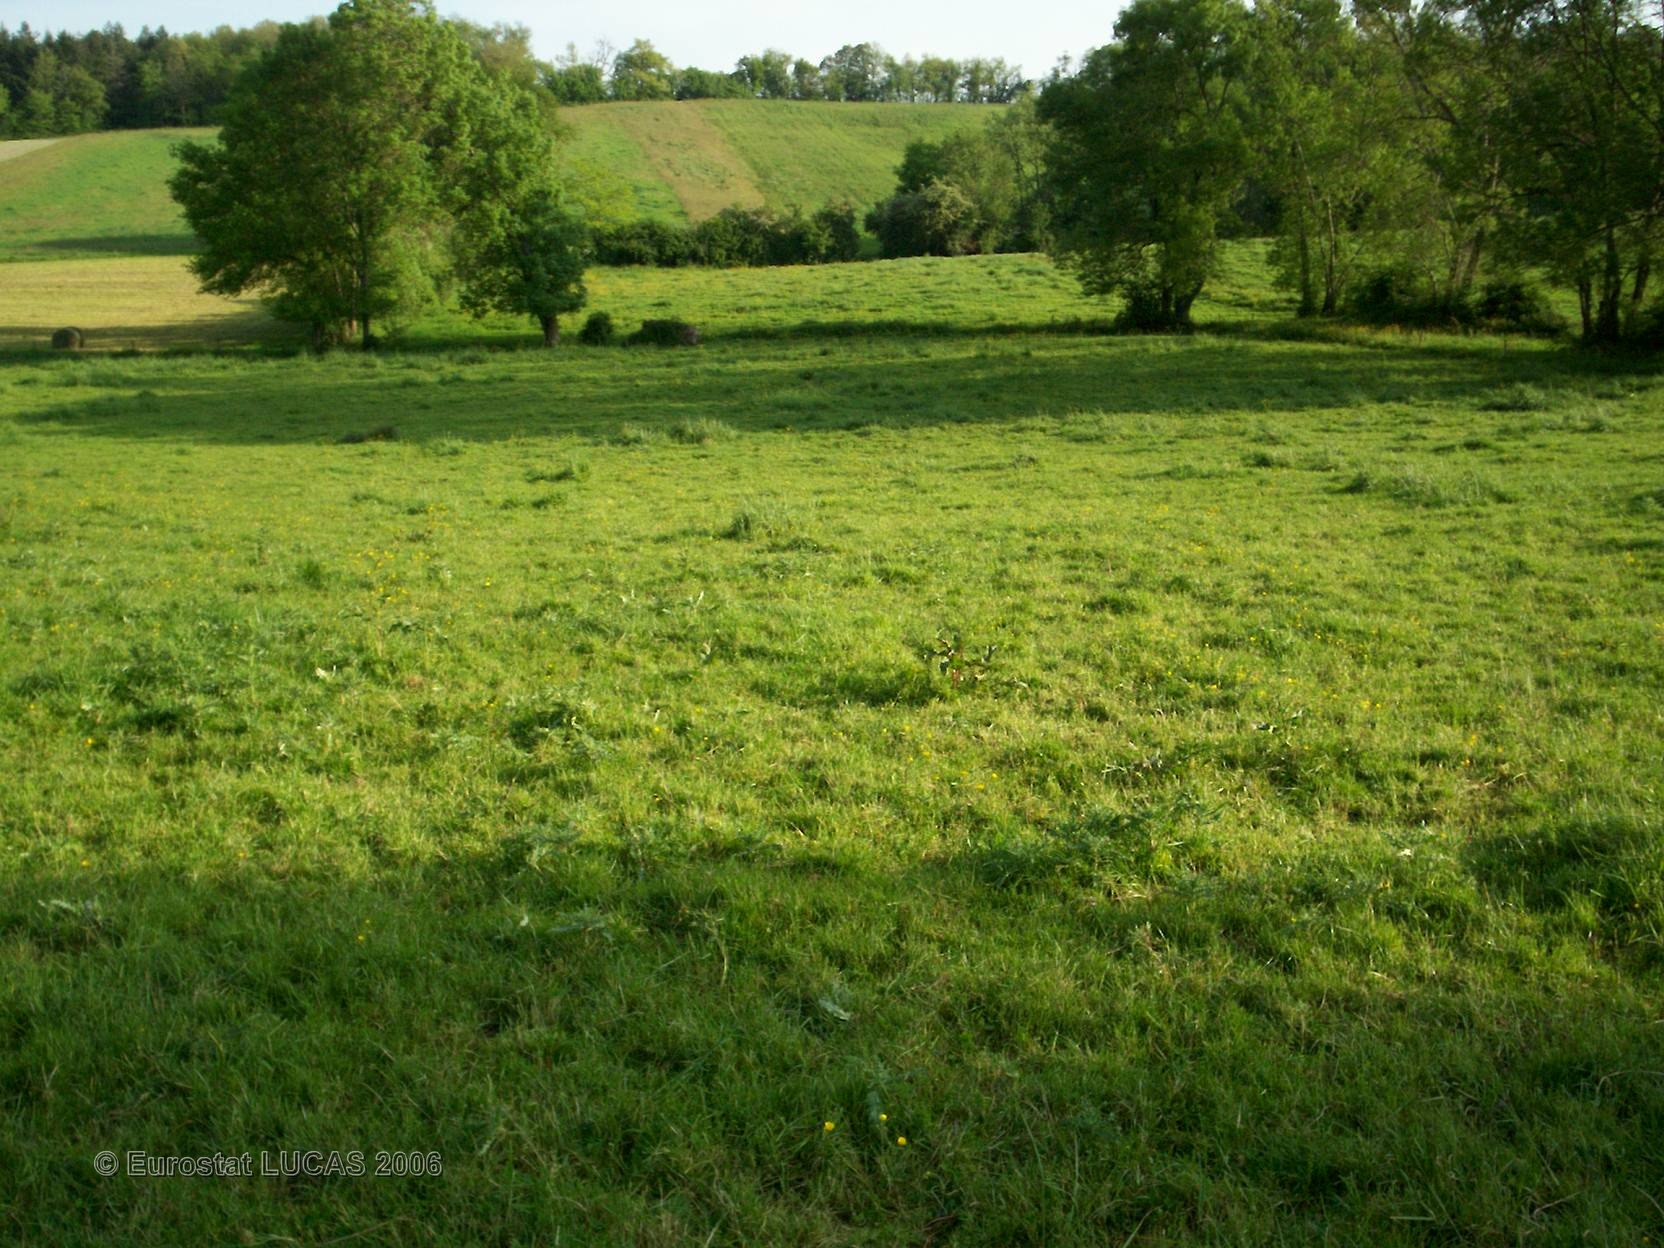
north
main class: Grassland
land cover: Grassland without tree/shrub cover
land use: Agriculture (excluding fallow land and kitchen gardens)
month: May
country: FR
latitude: 43.7938
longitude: 0.1885
